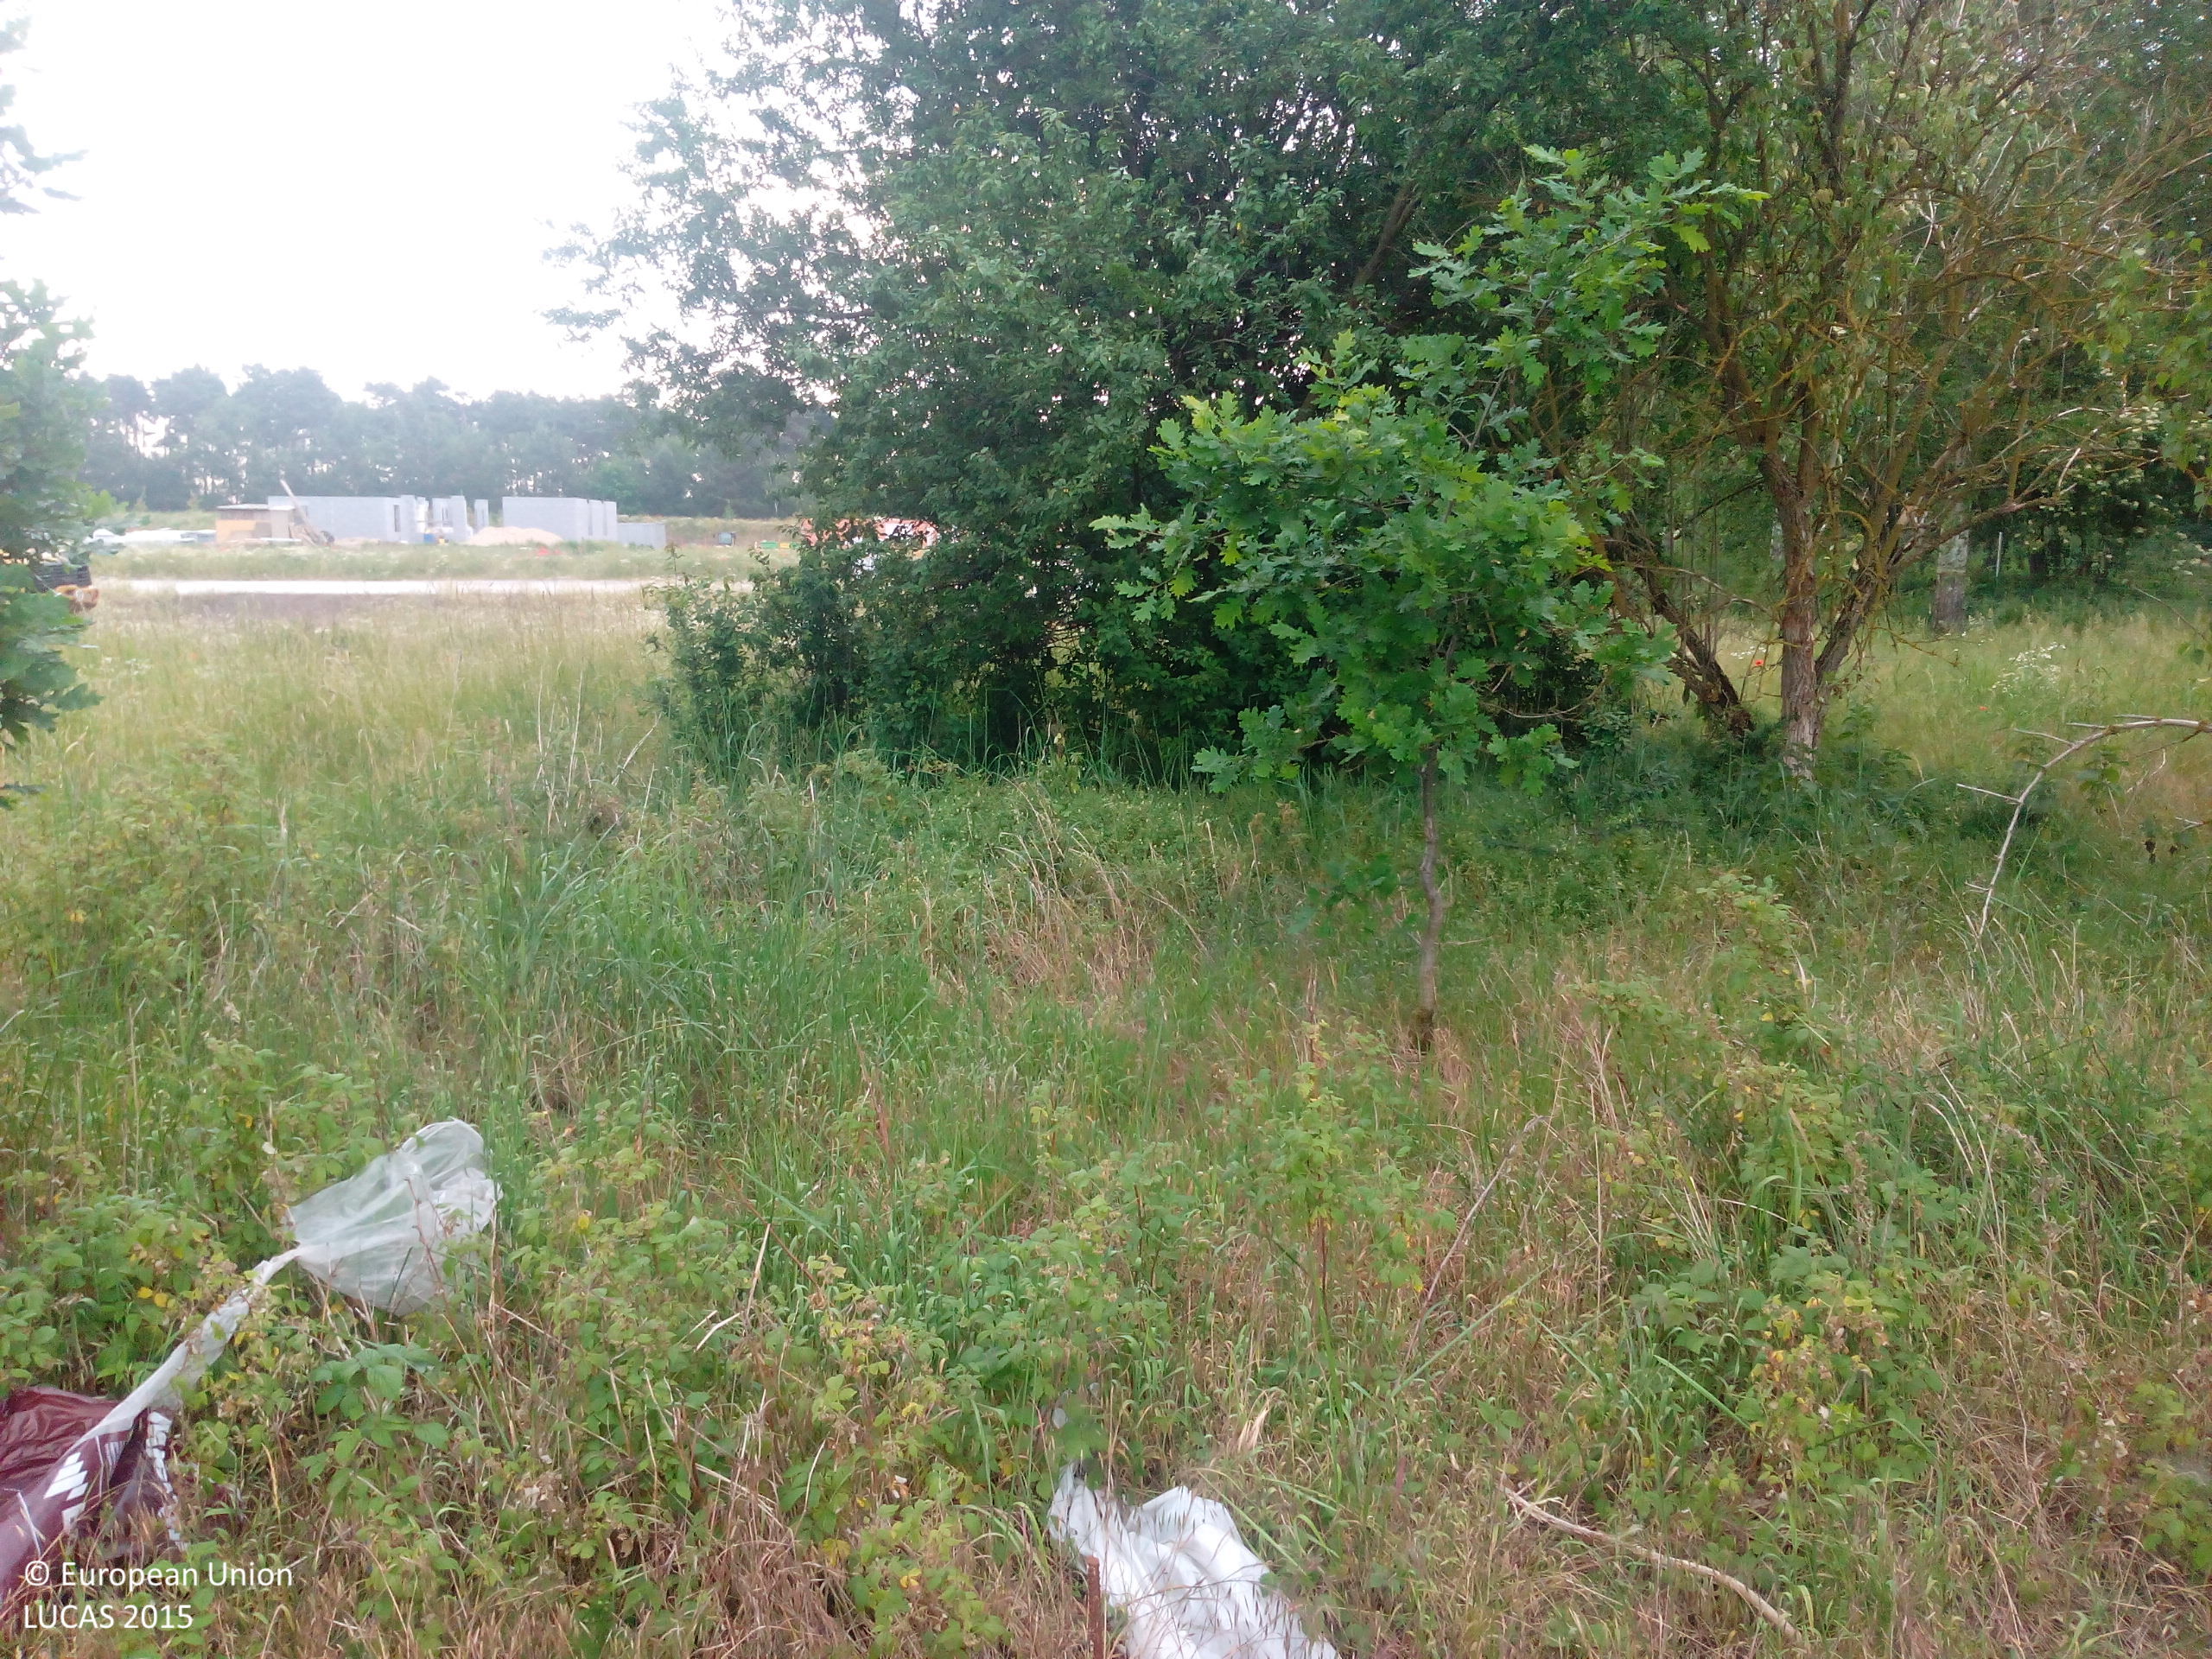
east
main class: Woodland
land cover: Broadleaved woodland
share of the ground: 25 - 50 %
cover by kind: herbaceous plants 60 %, broadleaved forest trees 30 %, shrubs 10 %
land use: Community services
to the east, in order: Broadleaved woodland; Grassland without tree/shrub cover; Tracks; Grassland without tree/shrub cover; Broadleaved woodland; Tracks; Grass margins; Paved roads, cycling and walking lanes; Grass margins; Ditches and canals; Fences; Pine dominated mixed woodland
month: June
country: DE
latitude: 52.4659
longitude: 10.5738
